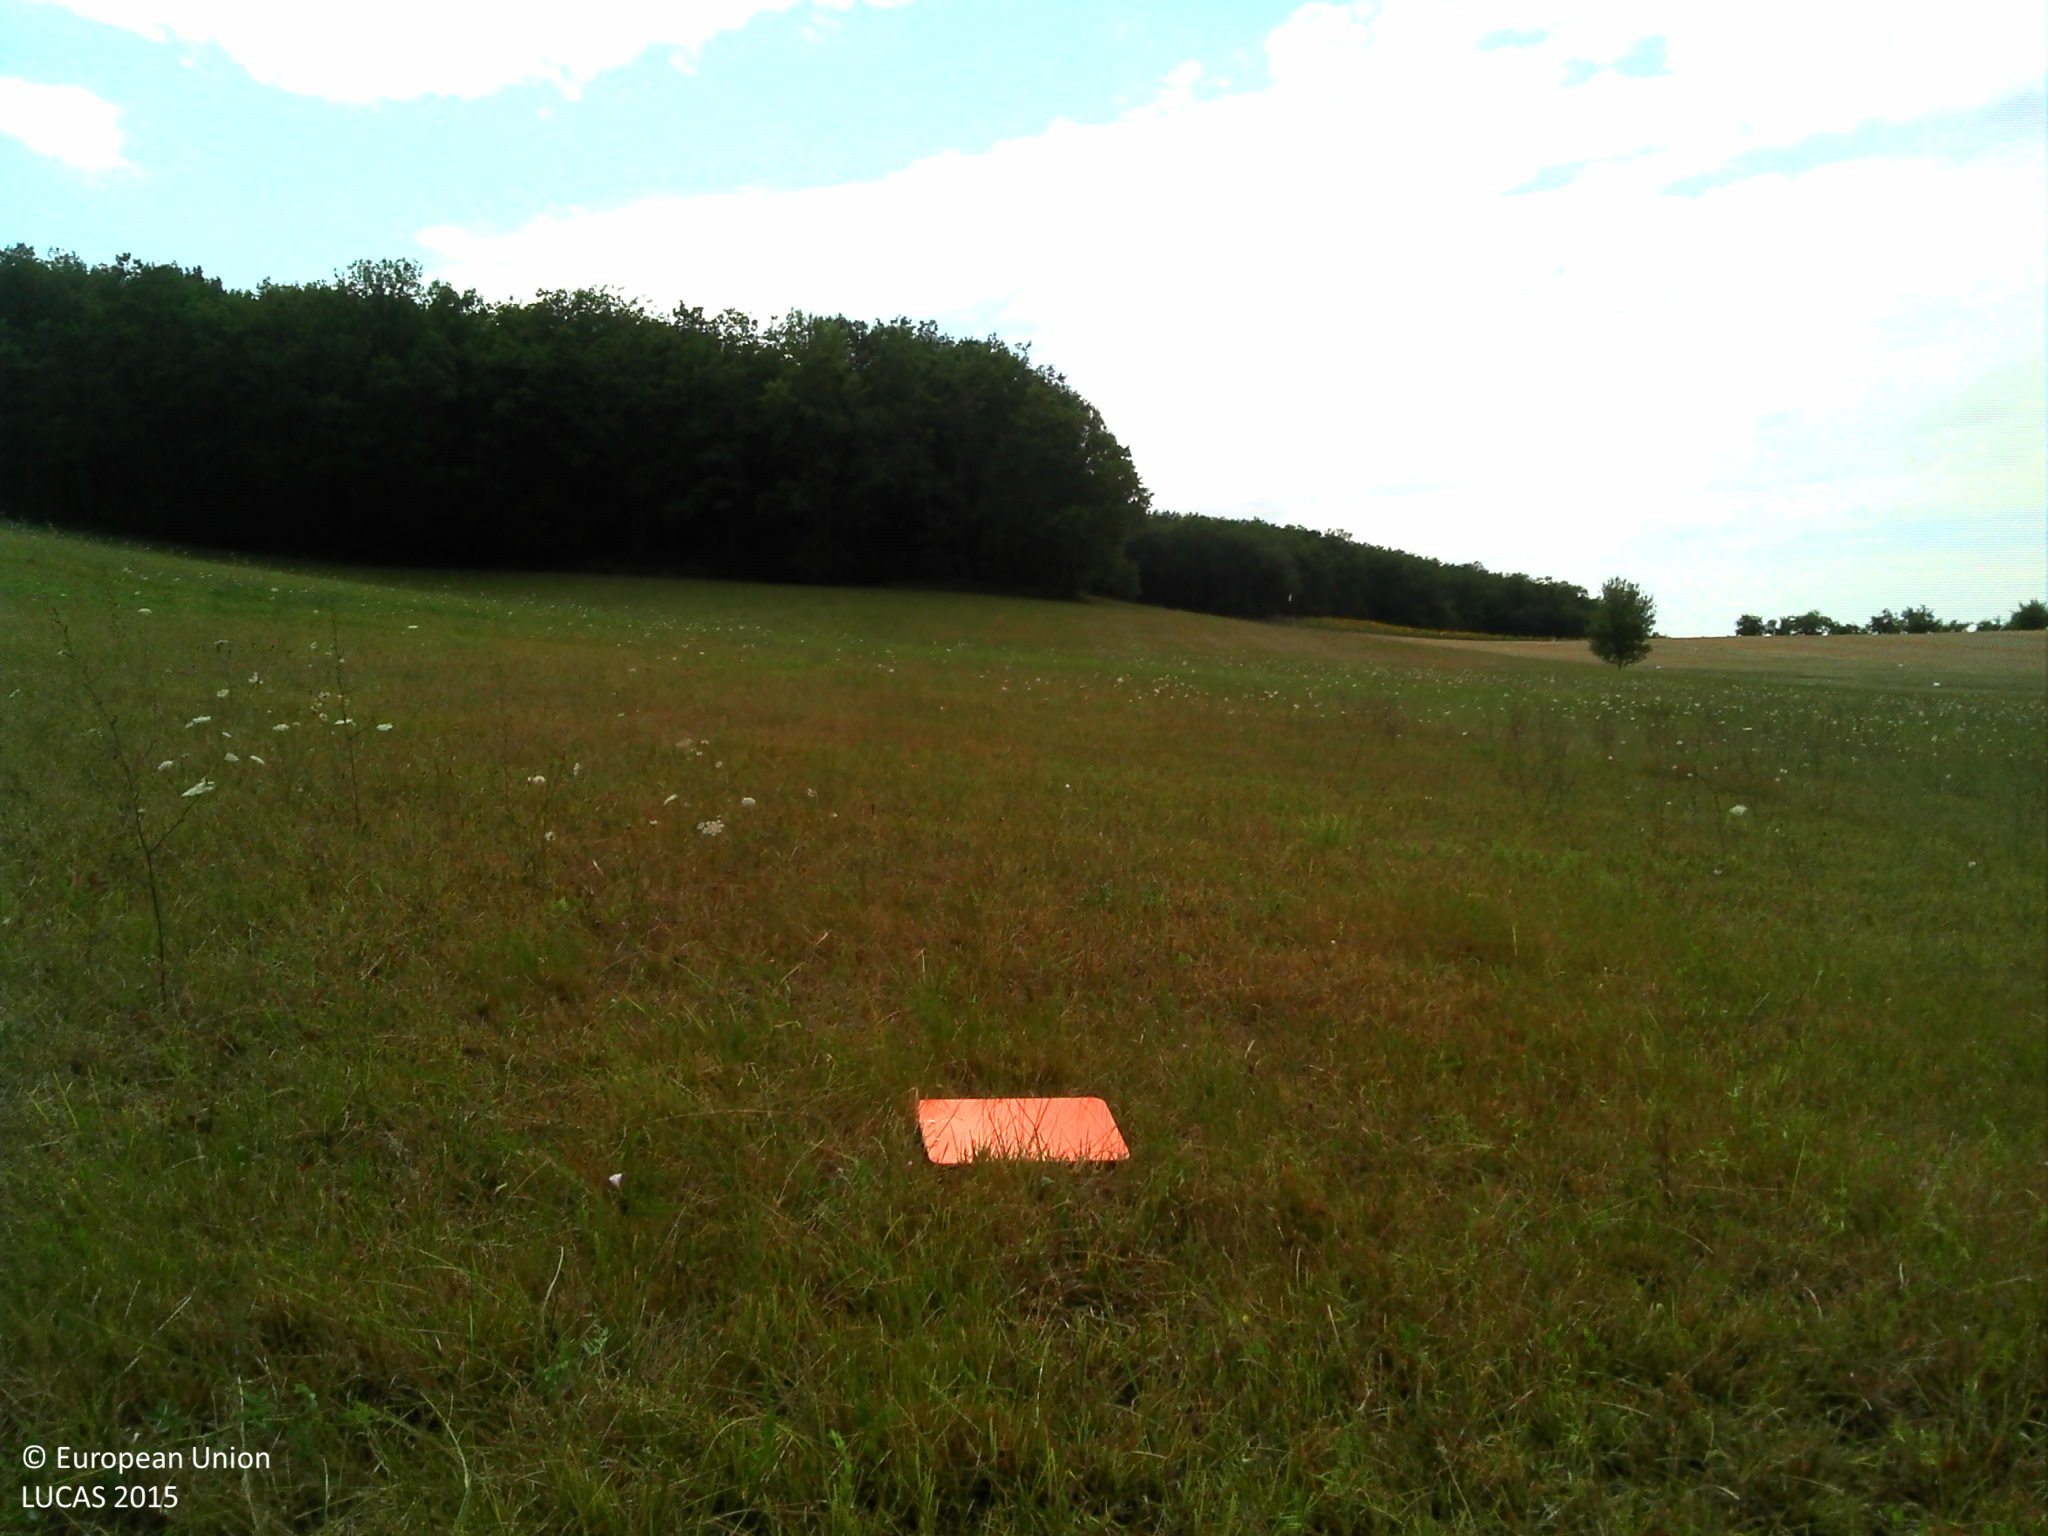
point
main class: Grassland
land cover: Grassland without tree/shrub cover
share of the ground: > 75 %
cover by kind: herbaceous plants 100 %
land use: Agriculture (excluding fallow land and kitchen gardens)
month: July
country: FR
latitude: 44.5906
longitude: 0.5573
